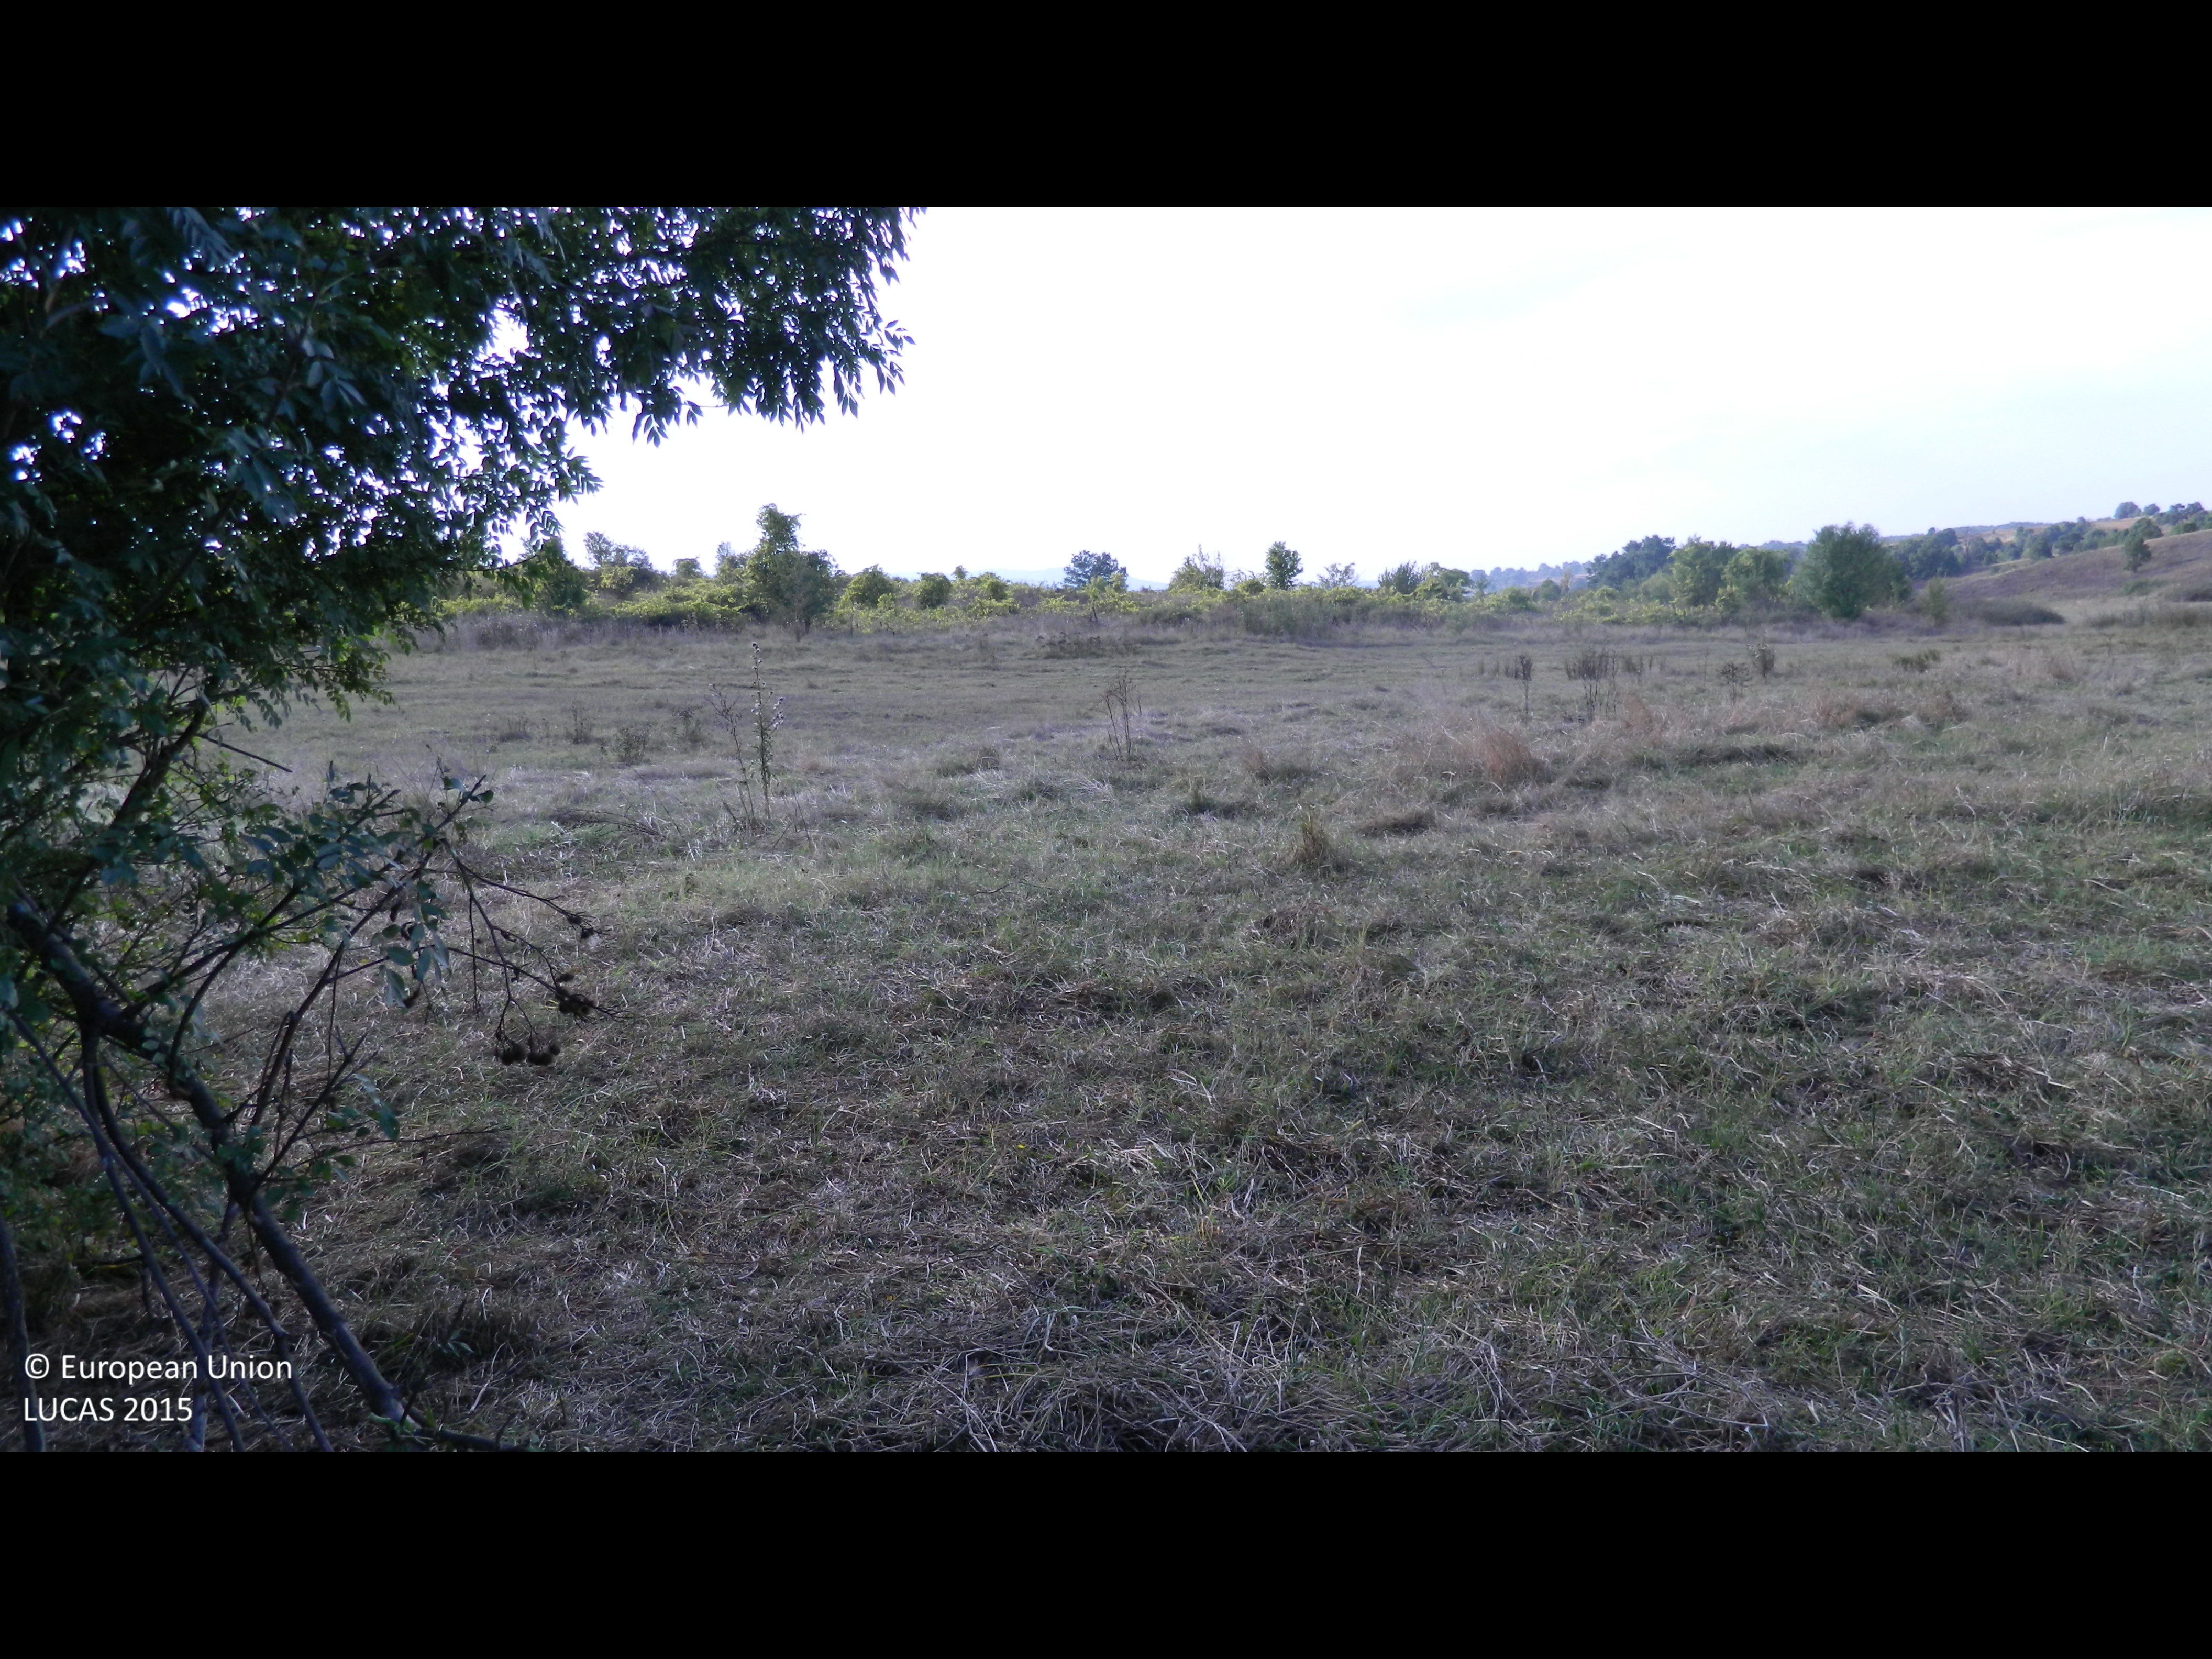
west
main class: Shrubland
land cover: Shrubland with sparse tree cover
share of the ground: > 75 %
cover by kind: shrubs 95 %, broadleaved forest trees 5 %
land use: Semi-natural and natural areas not in use
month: September
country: BG
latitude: 41.7598
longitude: 25.7624
